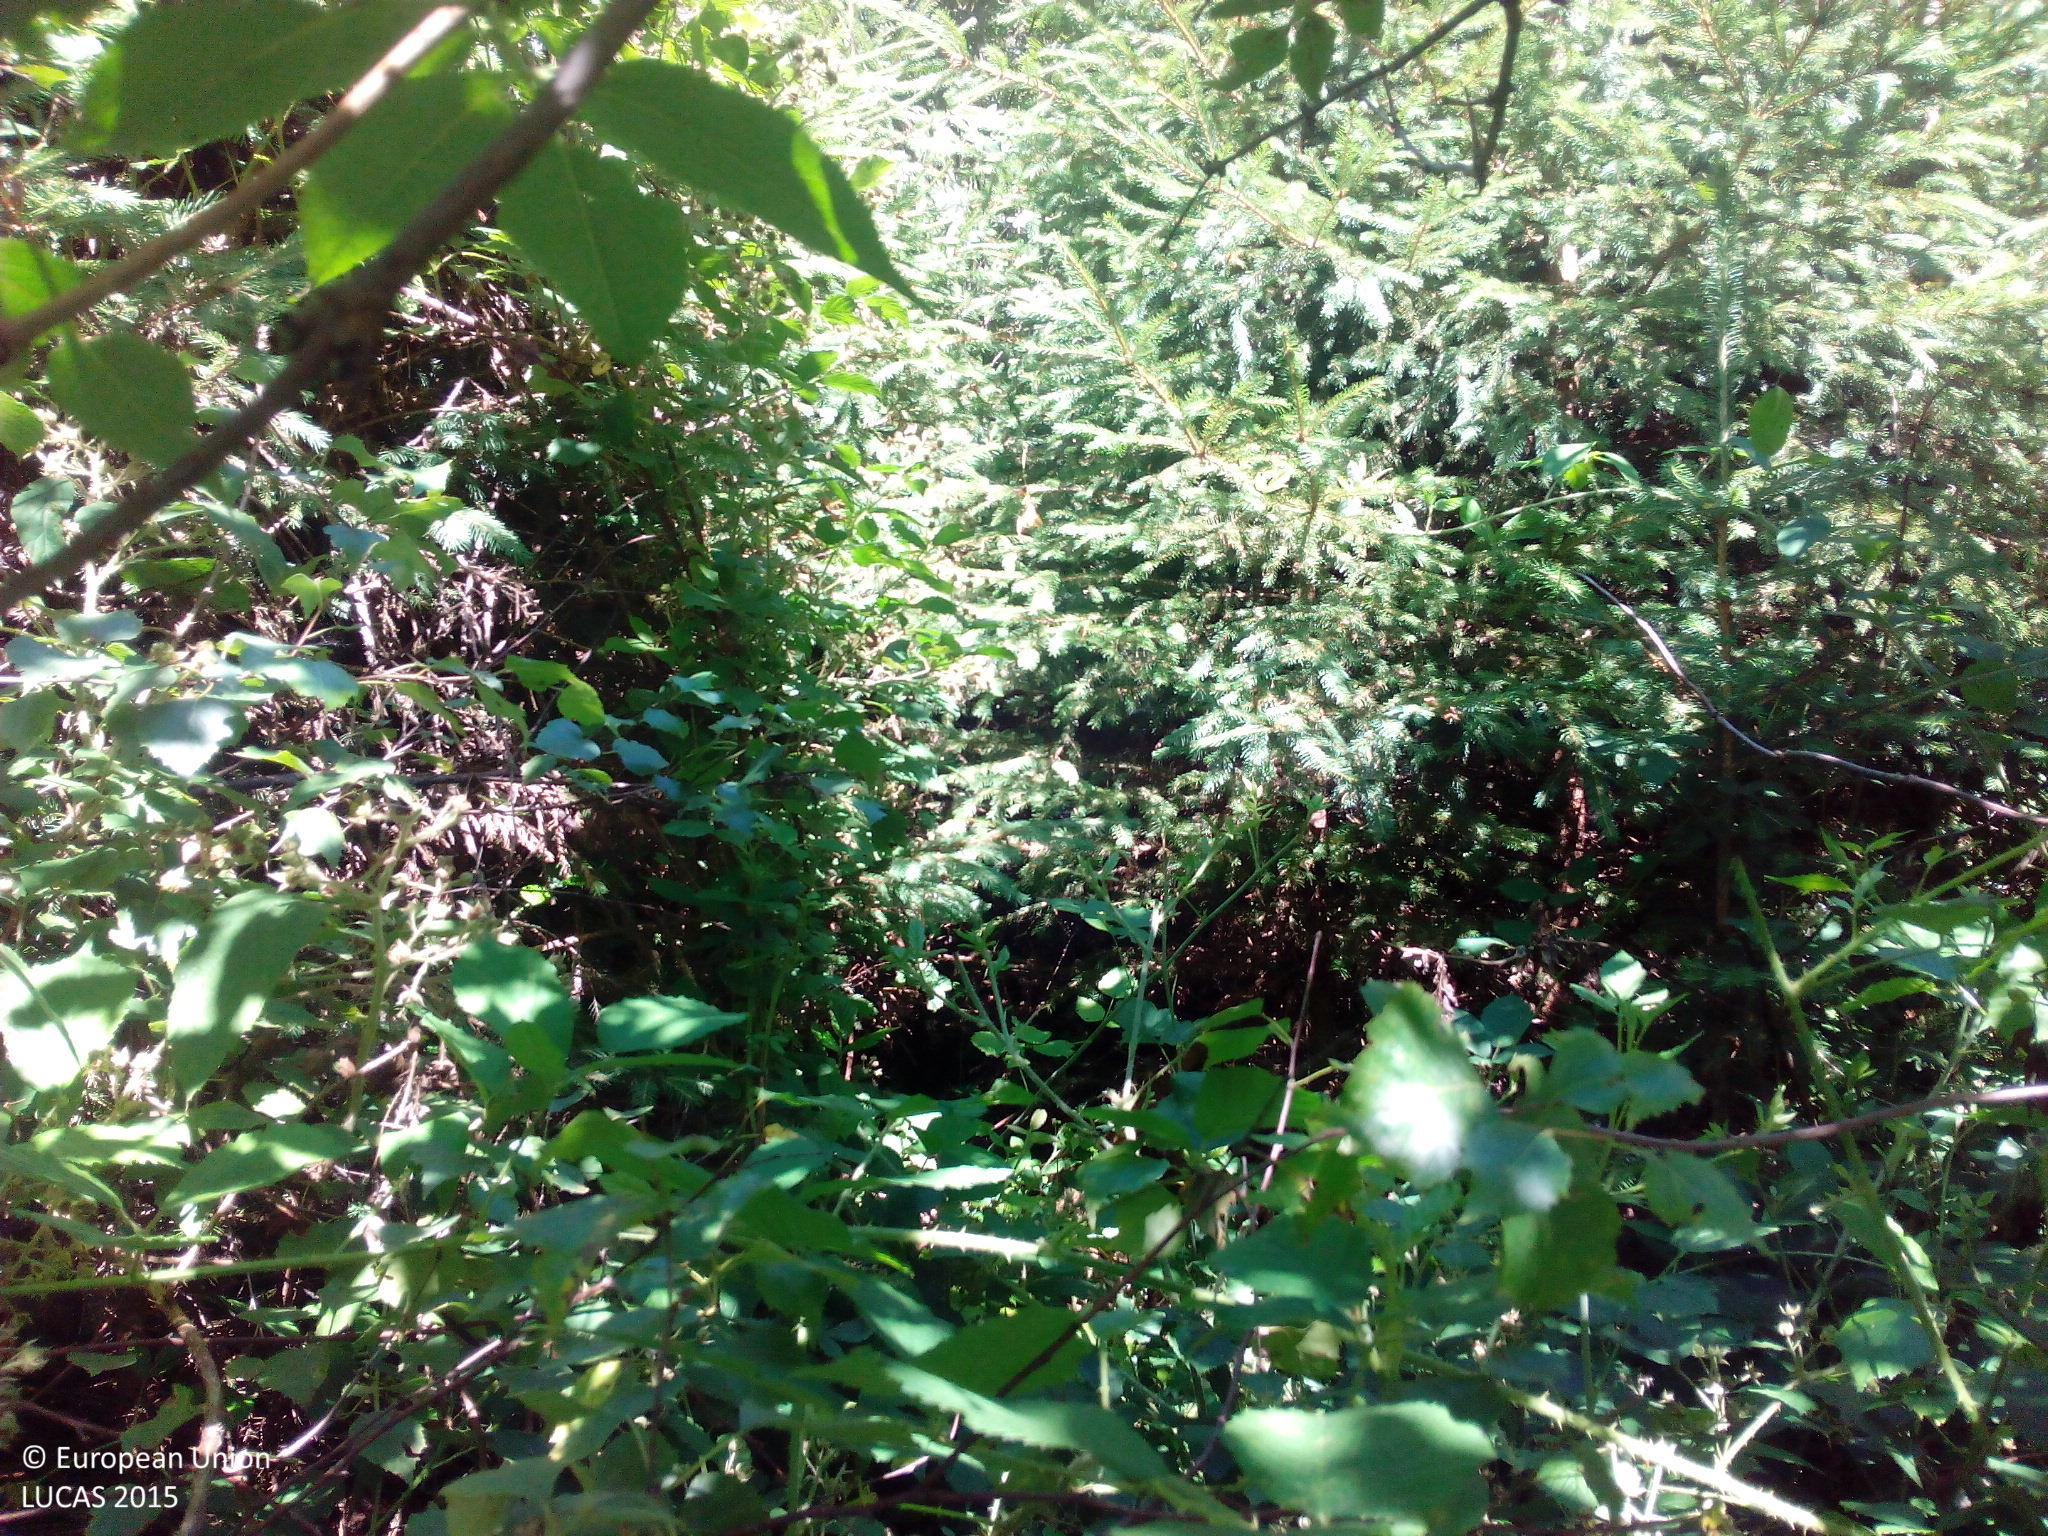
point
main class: Woodland
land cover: Spruce dominated coniferous woodland
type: hemiboreal forest and nemoral coniferous forest and mixed broadleaved-coniferous forest
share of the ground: > 75 %
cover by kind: coniferous forest trees 85 %, broadleaved forest trees 15 %
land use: Forestry
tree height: < 5 m
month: July
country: DE
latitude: 48.7093
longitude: 9.9593
